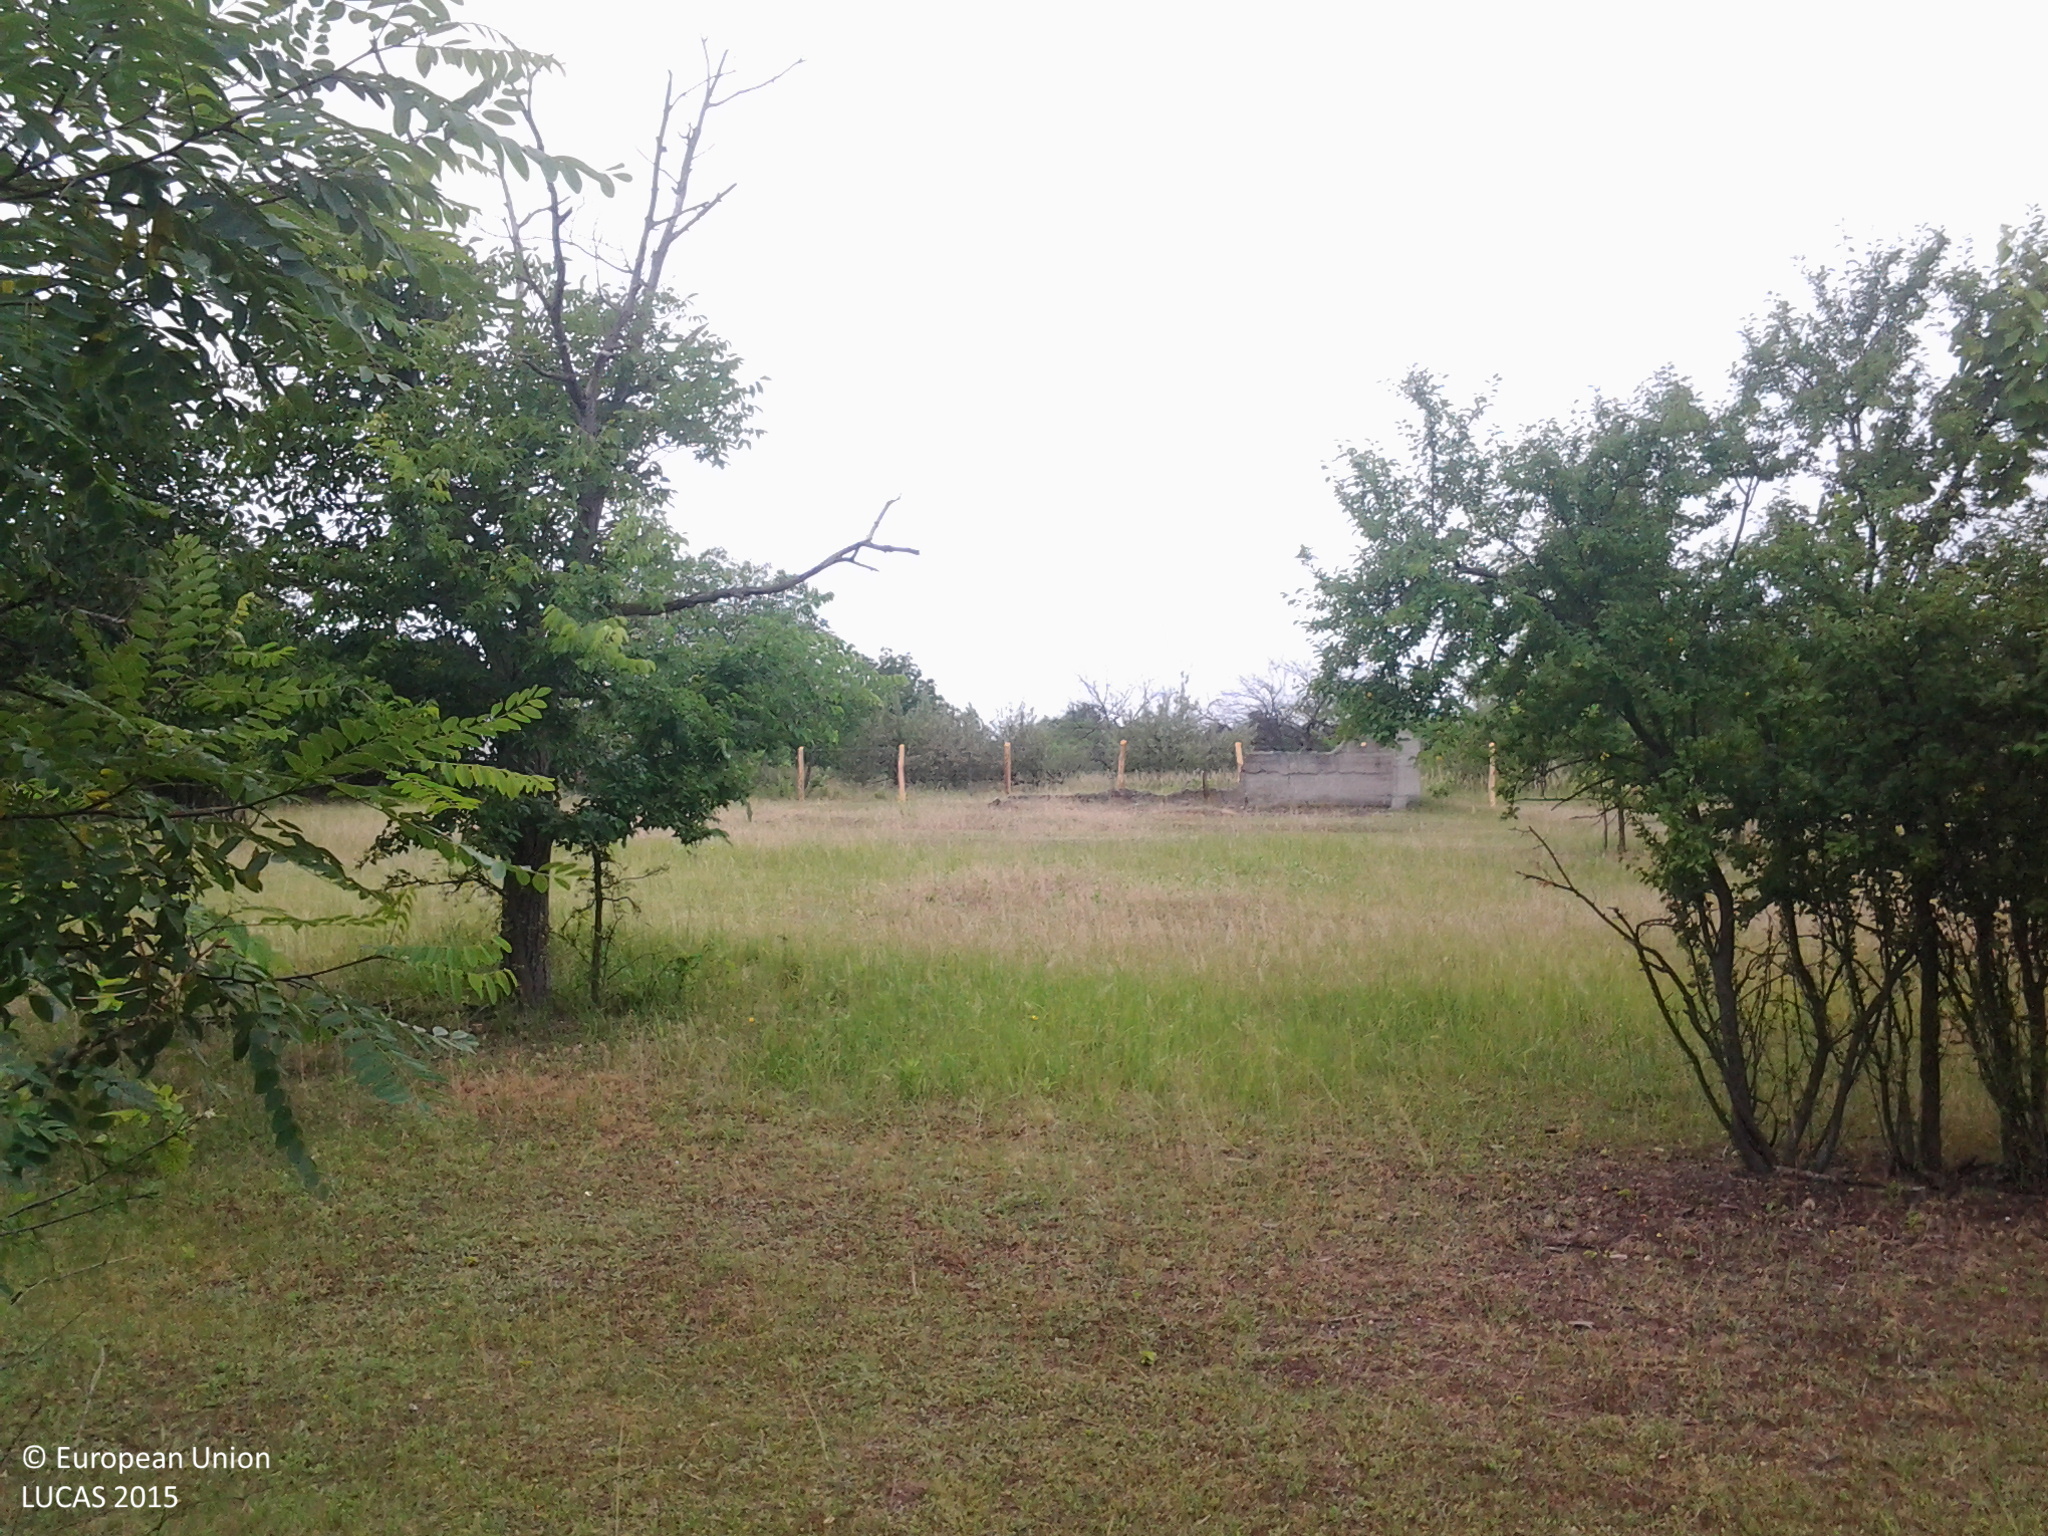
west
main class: Woodland
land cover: Broadleaved woodland
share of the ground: 10 - 25 %
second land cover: Grassland without tree/shrub cover
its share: > 75 %
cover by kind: herbaceous plants 80 %, broadleaved forest trees 20 %
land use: Forestry
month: June
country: HU
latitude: 46.9272
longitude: 19.6737
